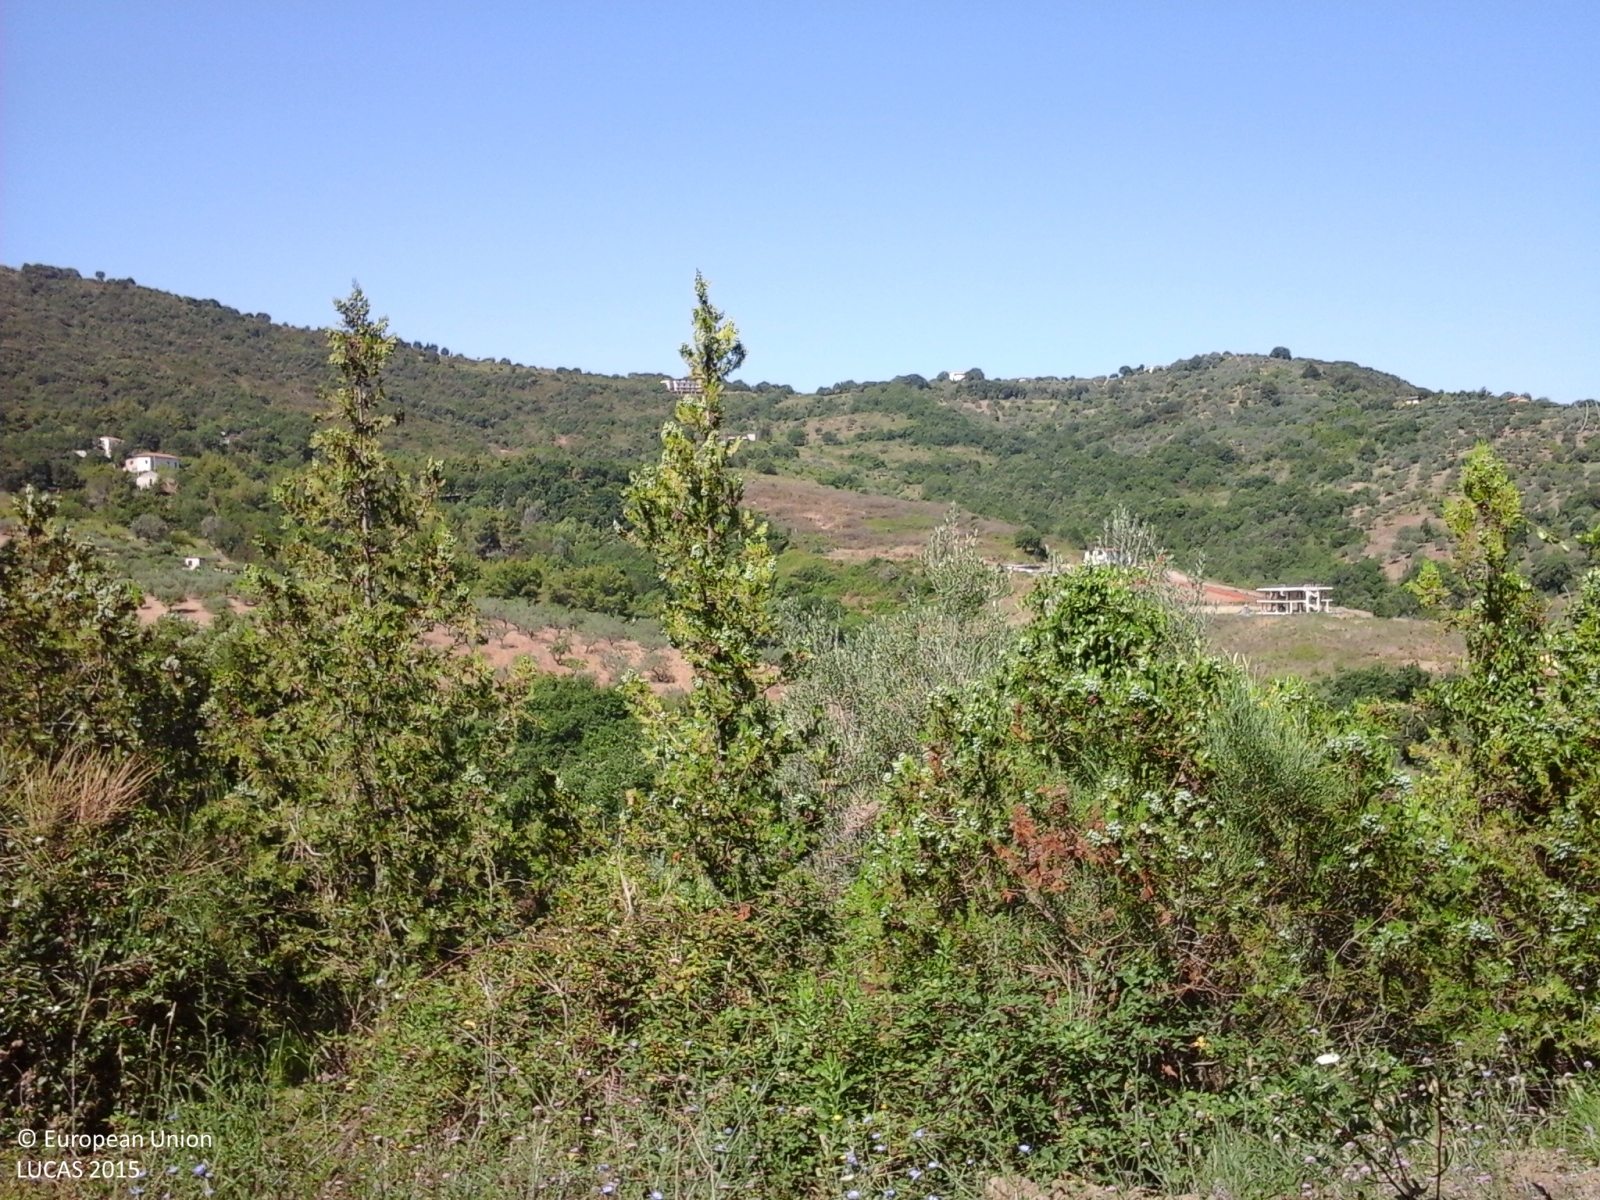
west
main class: Cropland
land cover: Olive groves
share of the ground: > 75 %
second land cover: Spontaneously vegetated surfaces
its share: > 75 %
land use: Kitchen garden
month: June
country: IT
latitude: 40.3715
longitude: 15.0775
